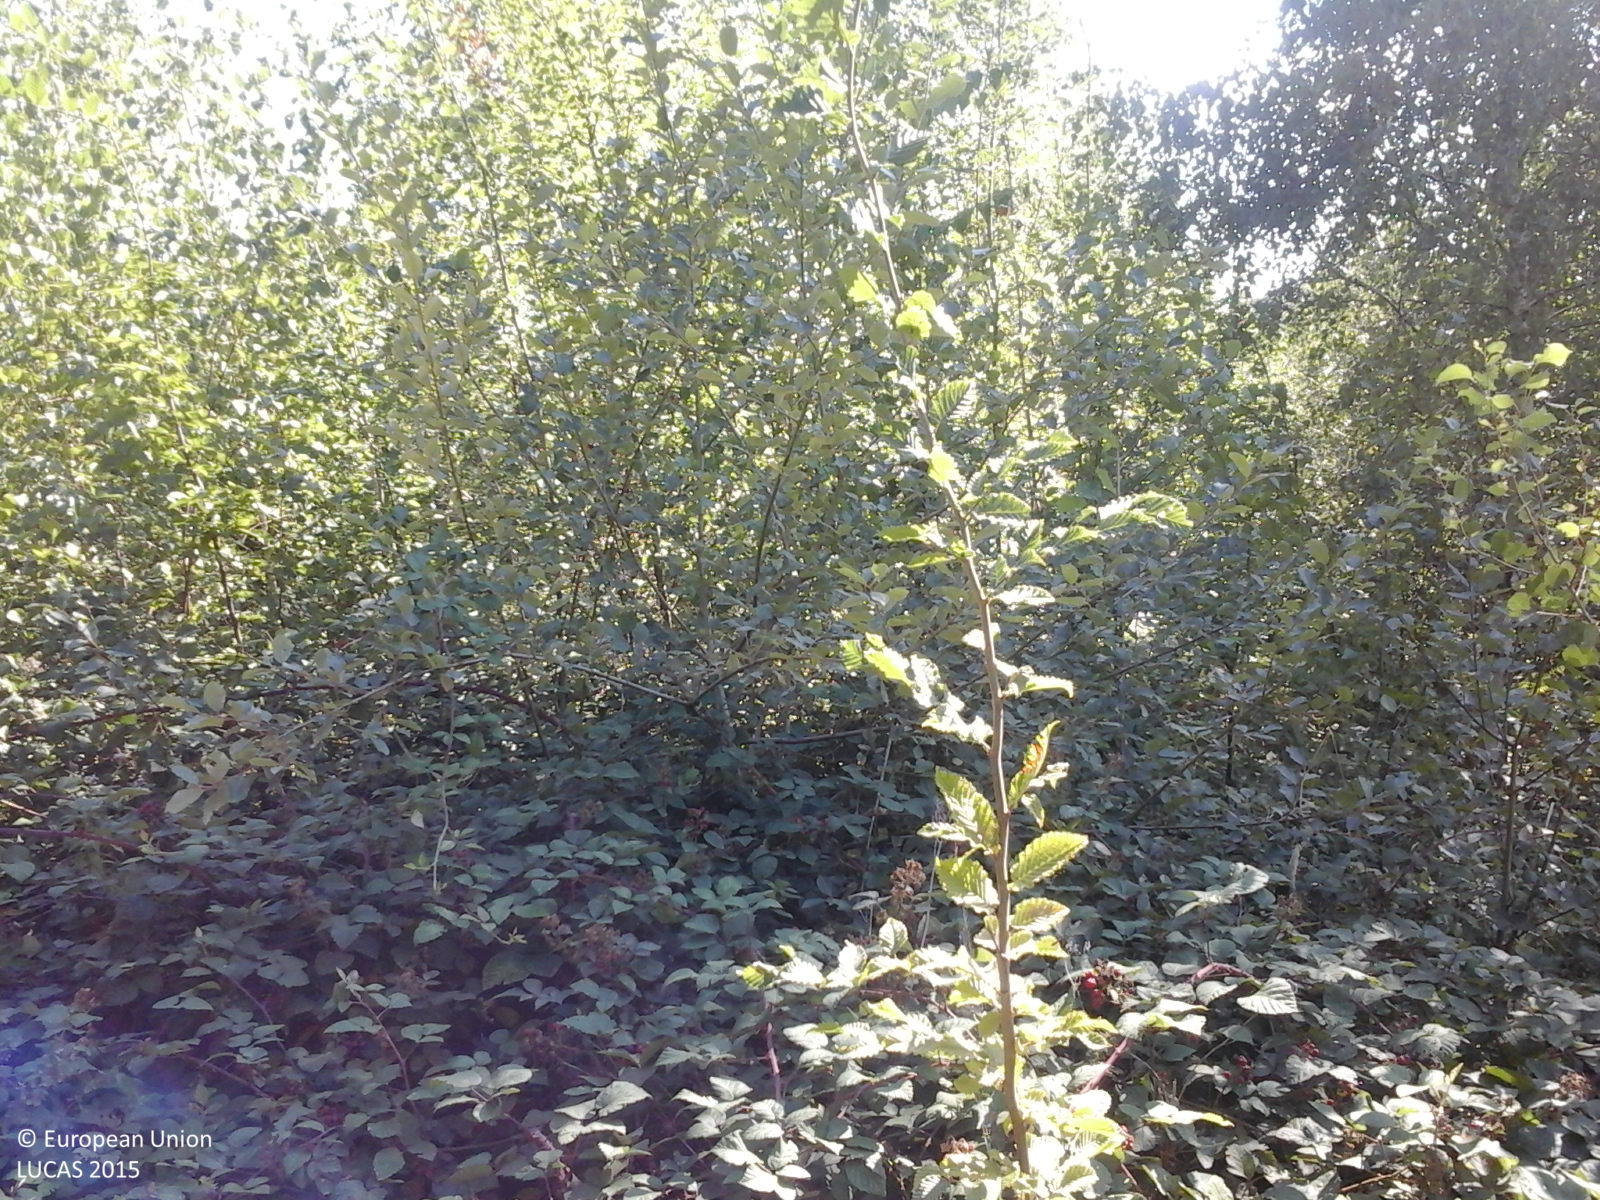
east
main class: Woodland
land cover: Broadleaved woodland
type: broadleaved evergreen forest
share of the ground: > 75 %
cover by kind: broadleaved forest trees 100 %
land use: Forestry
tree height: > 5 m
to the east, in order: Broadleaved woodland; Ditches and canals; Broadleaved woodland; Grassland with sparse tree/shrub cover; Tracks; Grassland with sparse tree/shrub cover; Broadleaved woodland
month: September
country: RO
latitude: 47.1665
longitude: 22.4685
